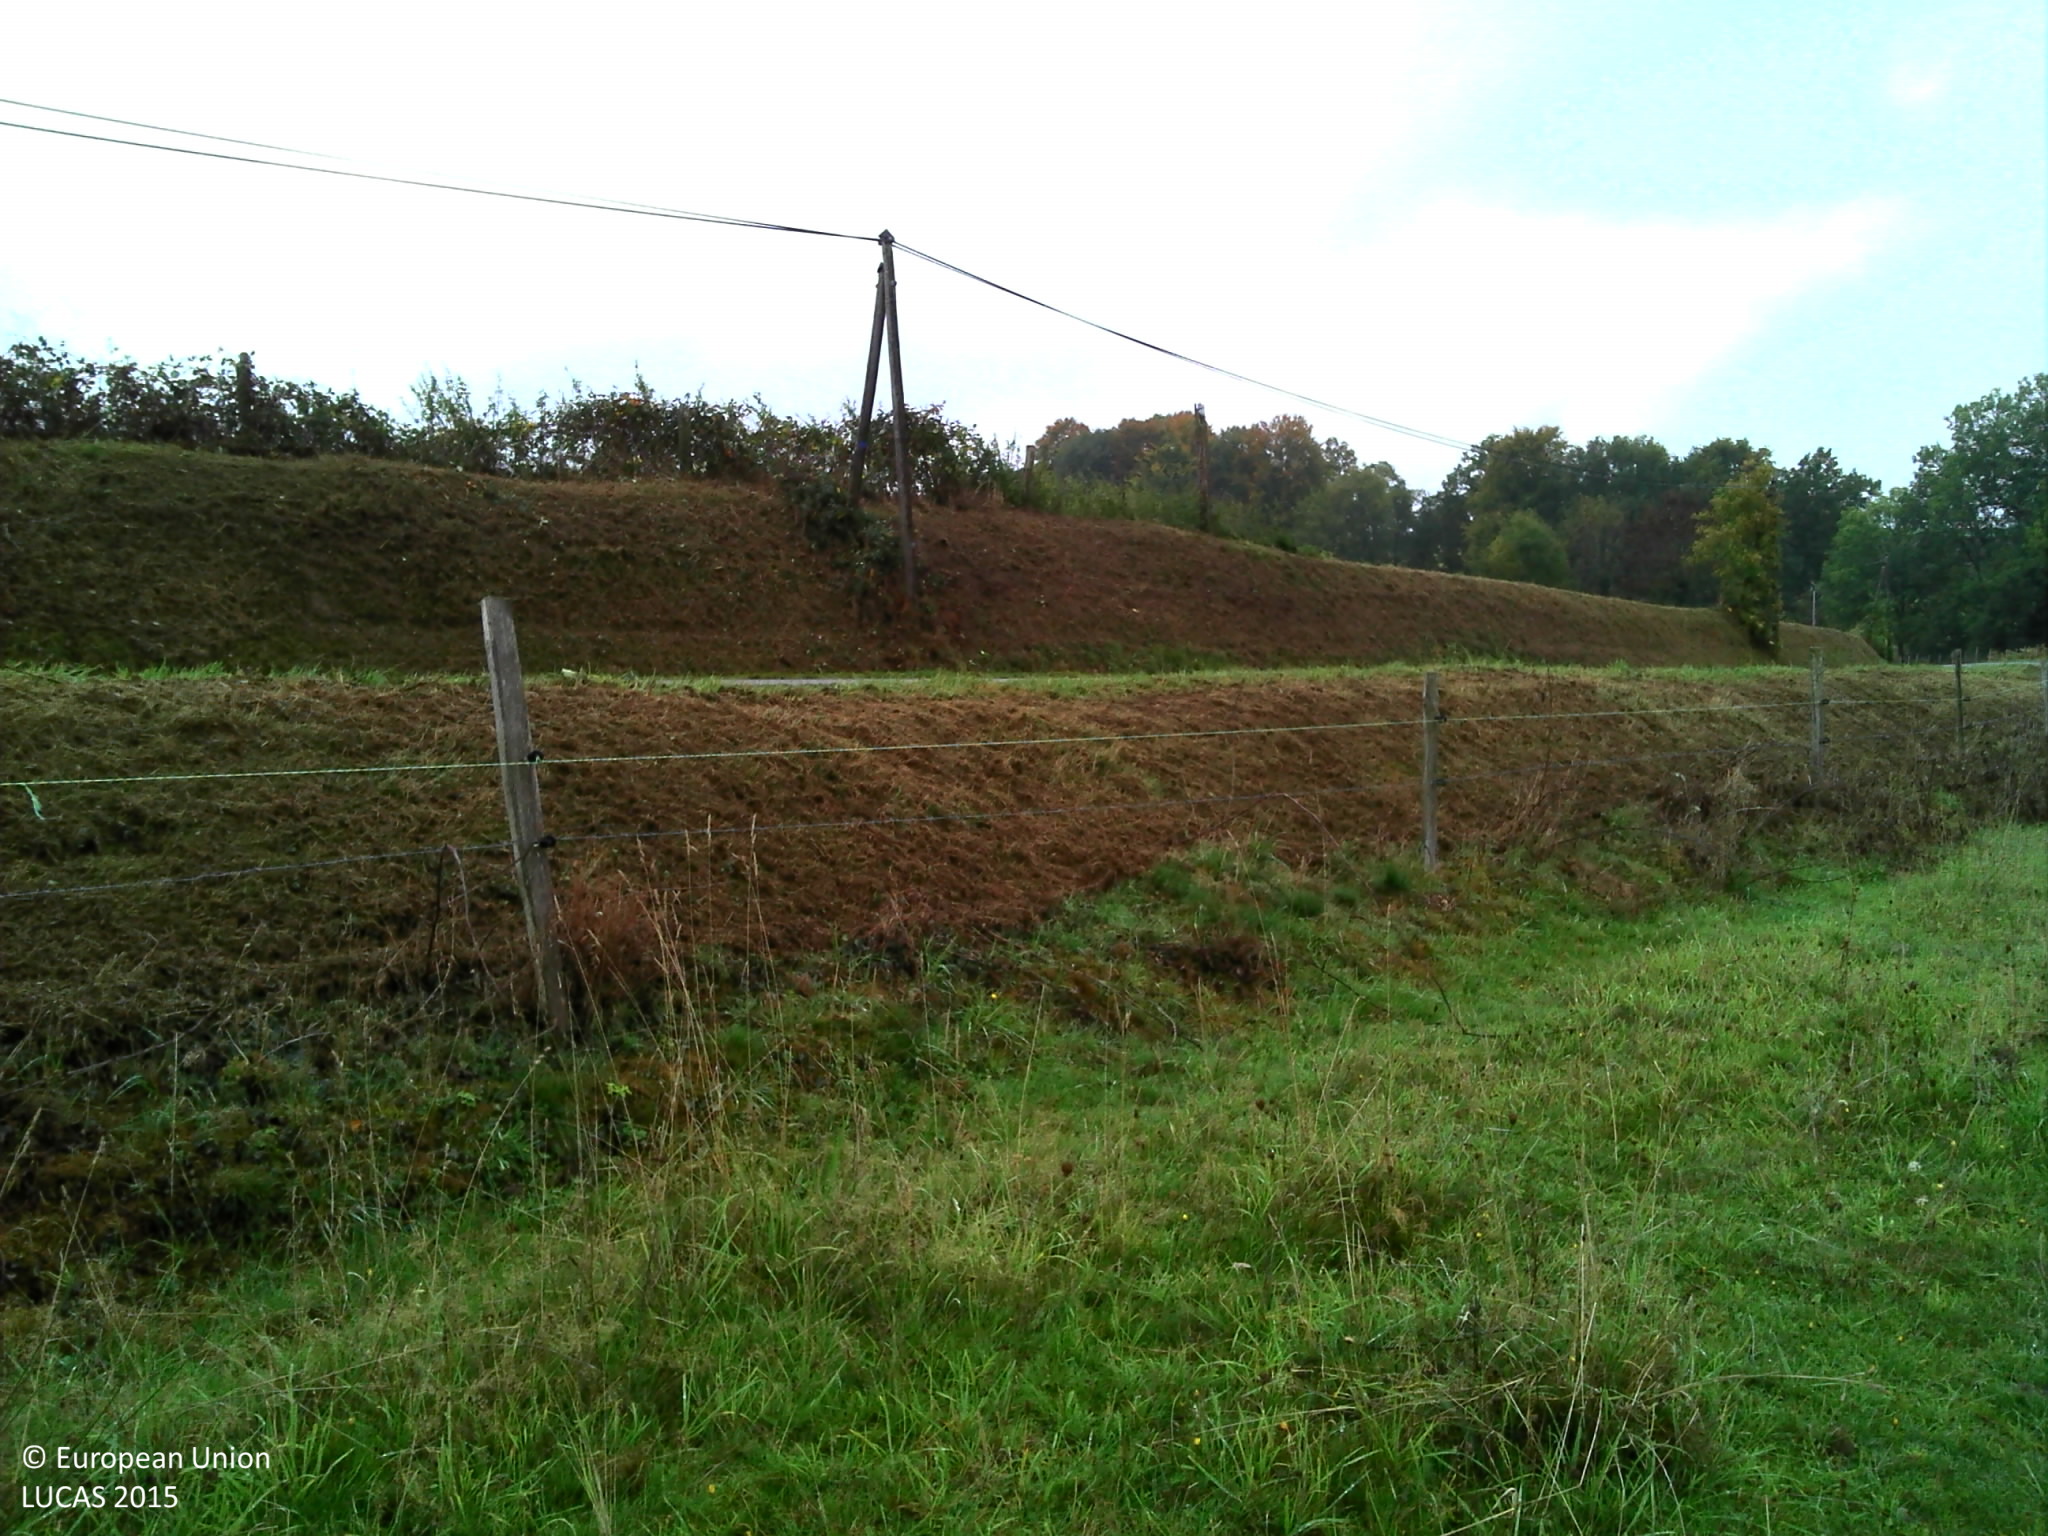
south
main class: Grassland
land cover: Grassland without tree/shrub cover
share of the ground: > 75 %
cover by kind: herbaceous plants 100 %
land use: Agriculture (excluding fallow land and kitchen gardens)
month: October
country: FR
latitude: 45.9662
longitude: 2.8361
